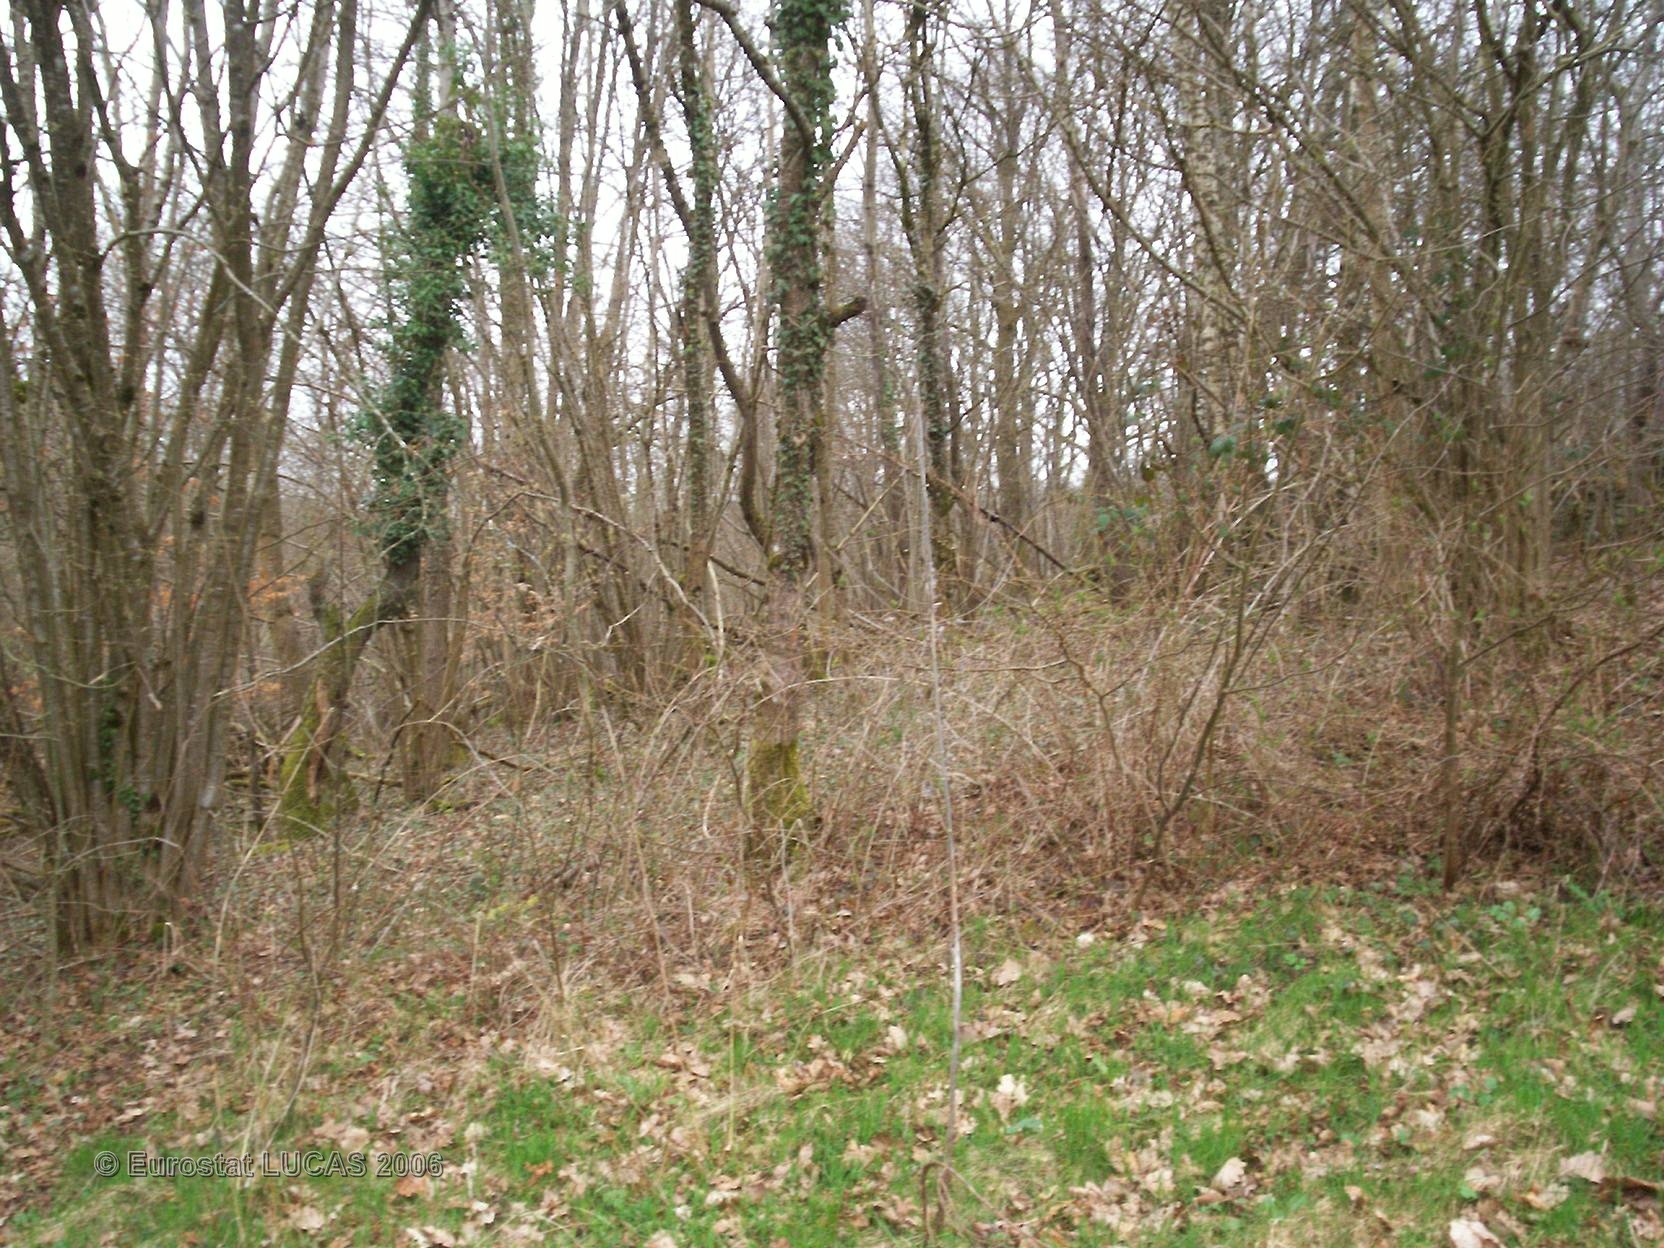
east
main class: Grassland
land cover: Grassland without tree/shrub cover
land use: Agriculture (excluding fallow land and kitchen gardens)
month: April
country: FR
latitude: 47.9981
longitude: 6.2616
